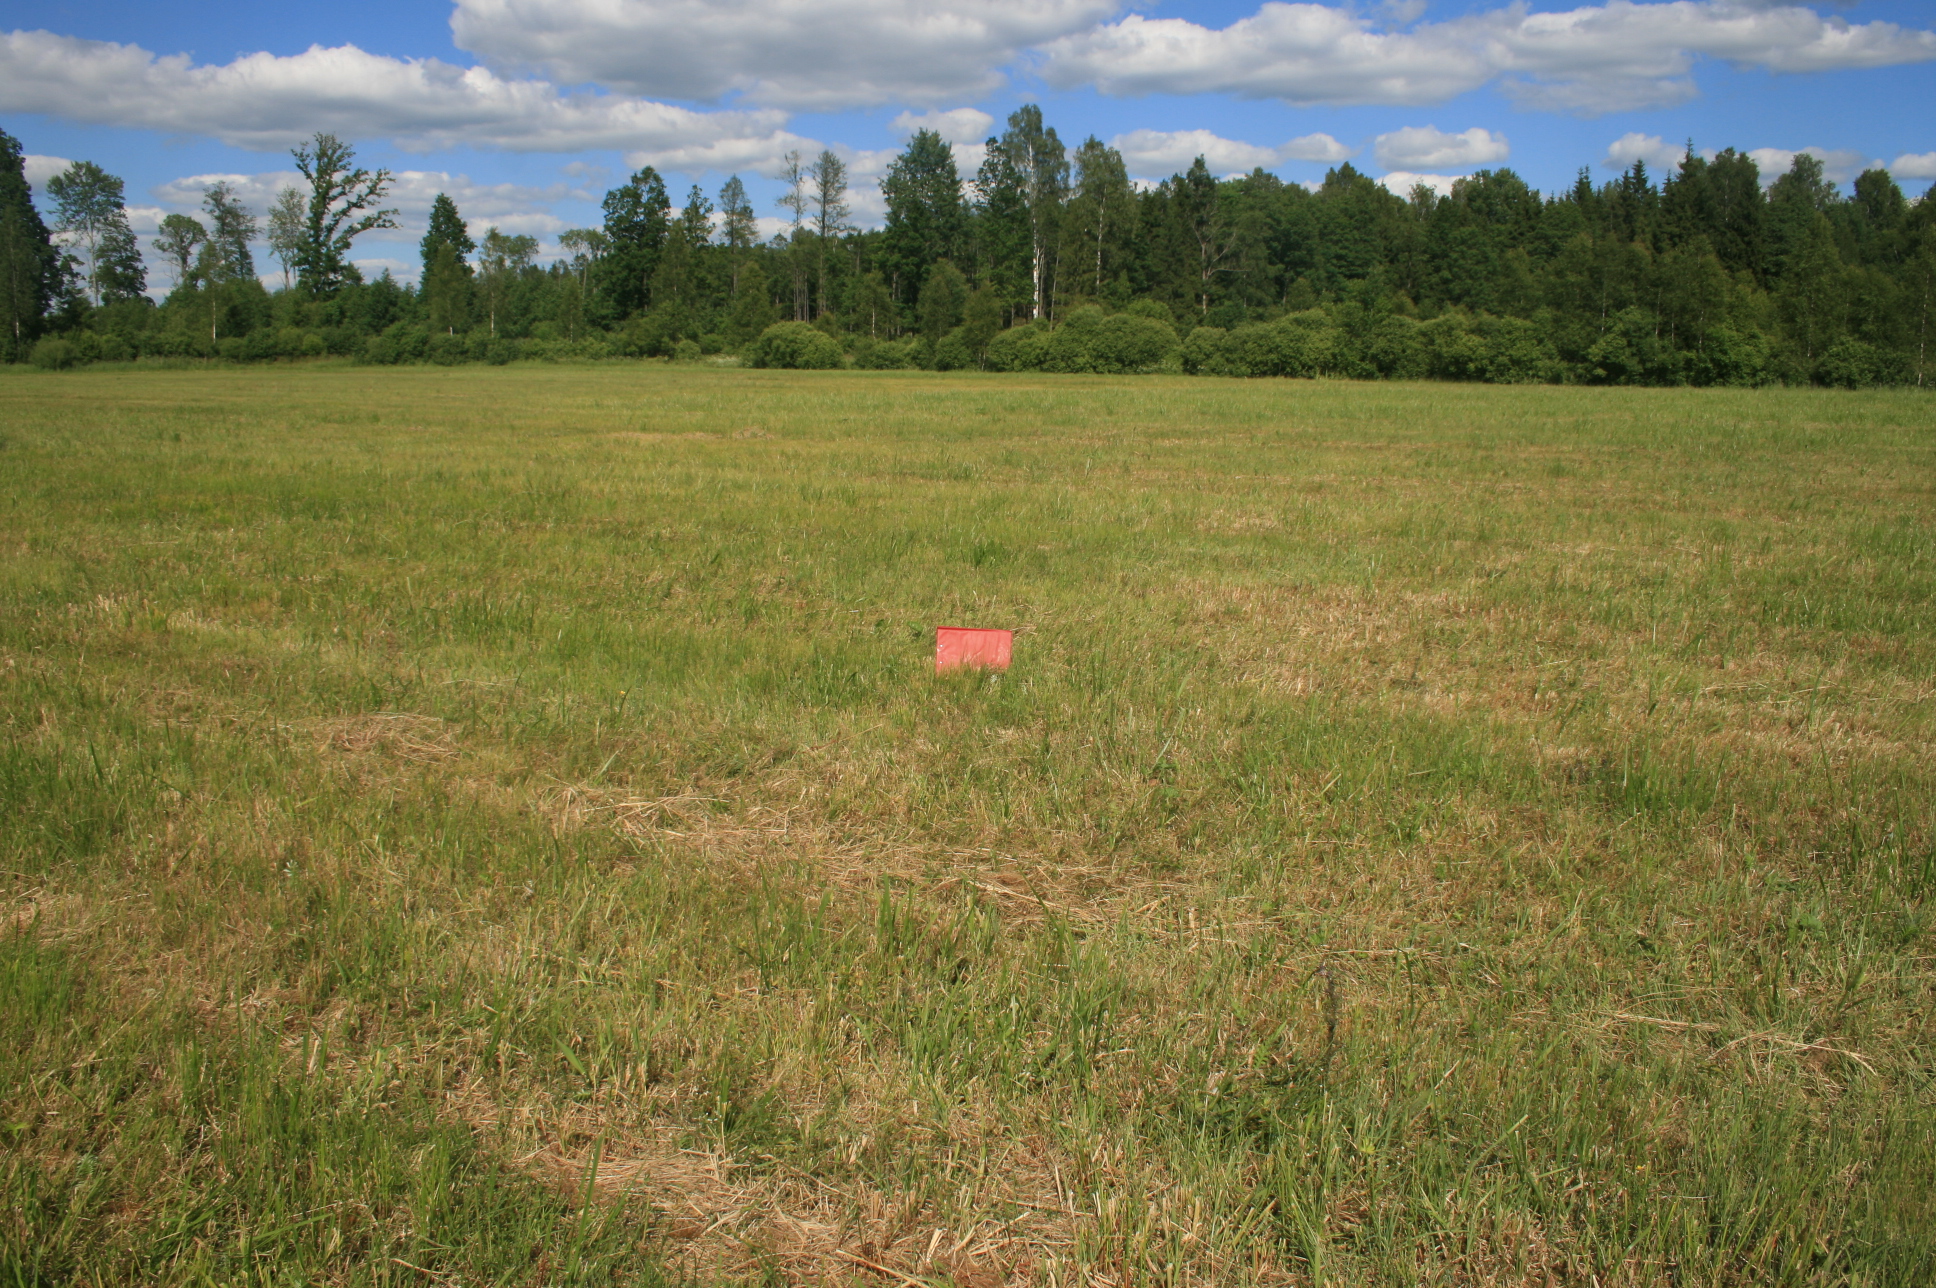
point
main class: Grassland
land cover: Grassland without tree/shrub cover
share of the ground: > 75 %
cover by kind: herbaceous plants 95 %, lichens and mosses 5 %
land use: Agriculture (excluding fallow land and kitchen gardens)
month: June
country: LT
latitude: 55.4087
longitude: 22.1380
